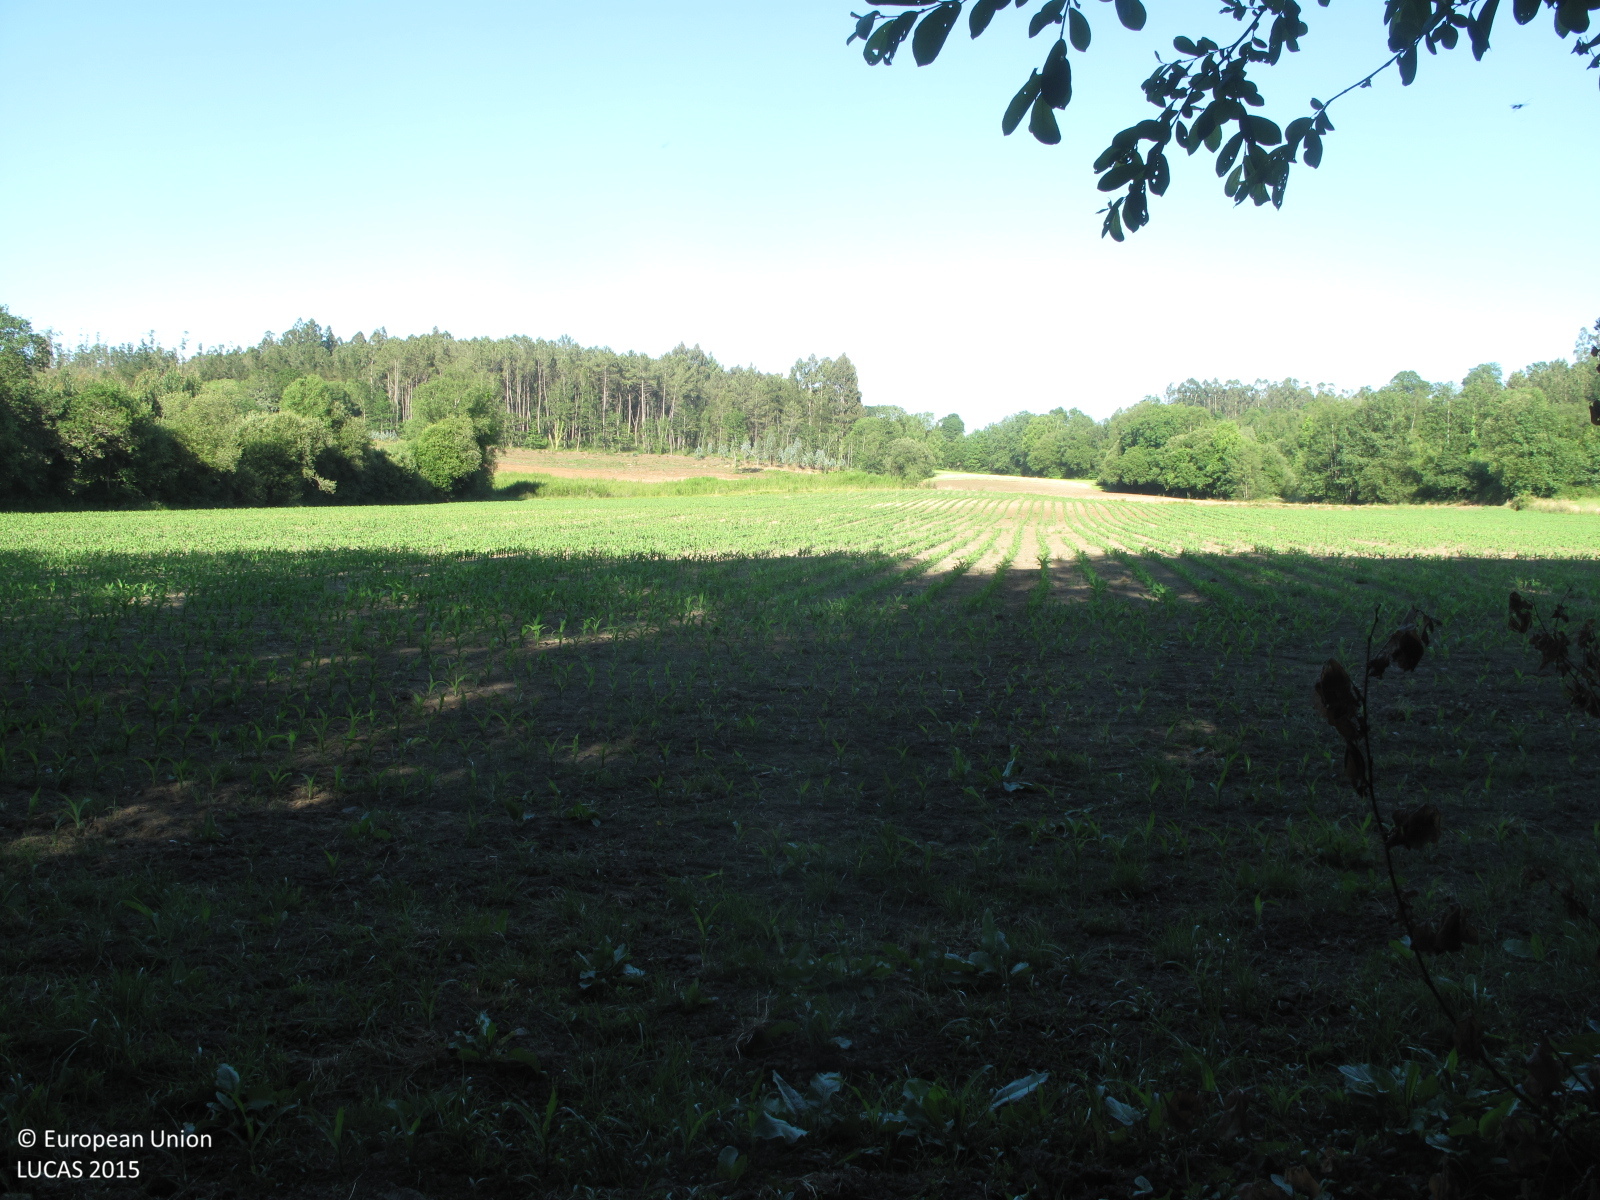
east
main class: Woodland
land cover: Broadleaved woodland
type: non-riverine alder, birch or aspen forest
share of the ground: > 75 %
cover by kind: broadleaved forest trees 90 %, shrubs 10 %
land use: Forestry
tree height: > 5 m
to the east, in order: Broadleaved woodland; Maize; Grass margins; Tracks; Shruby margins; Other bare soil; Grass margins; Other bare soil
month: June
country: ES
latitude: 43.0069
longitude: -8.5708
